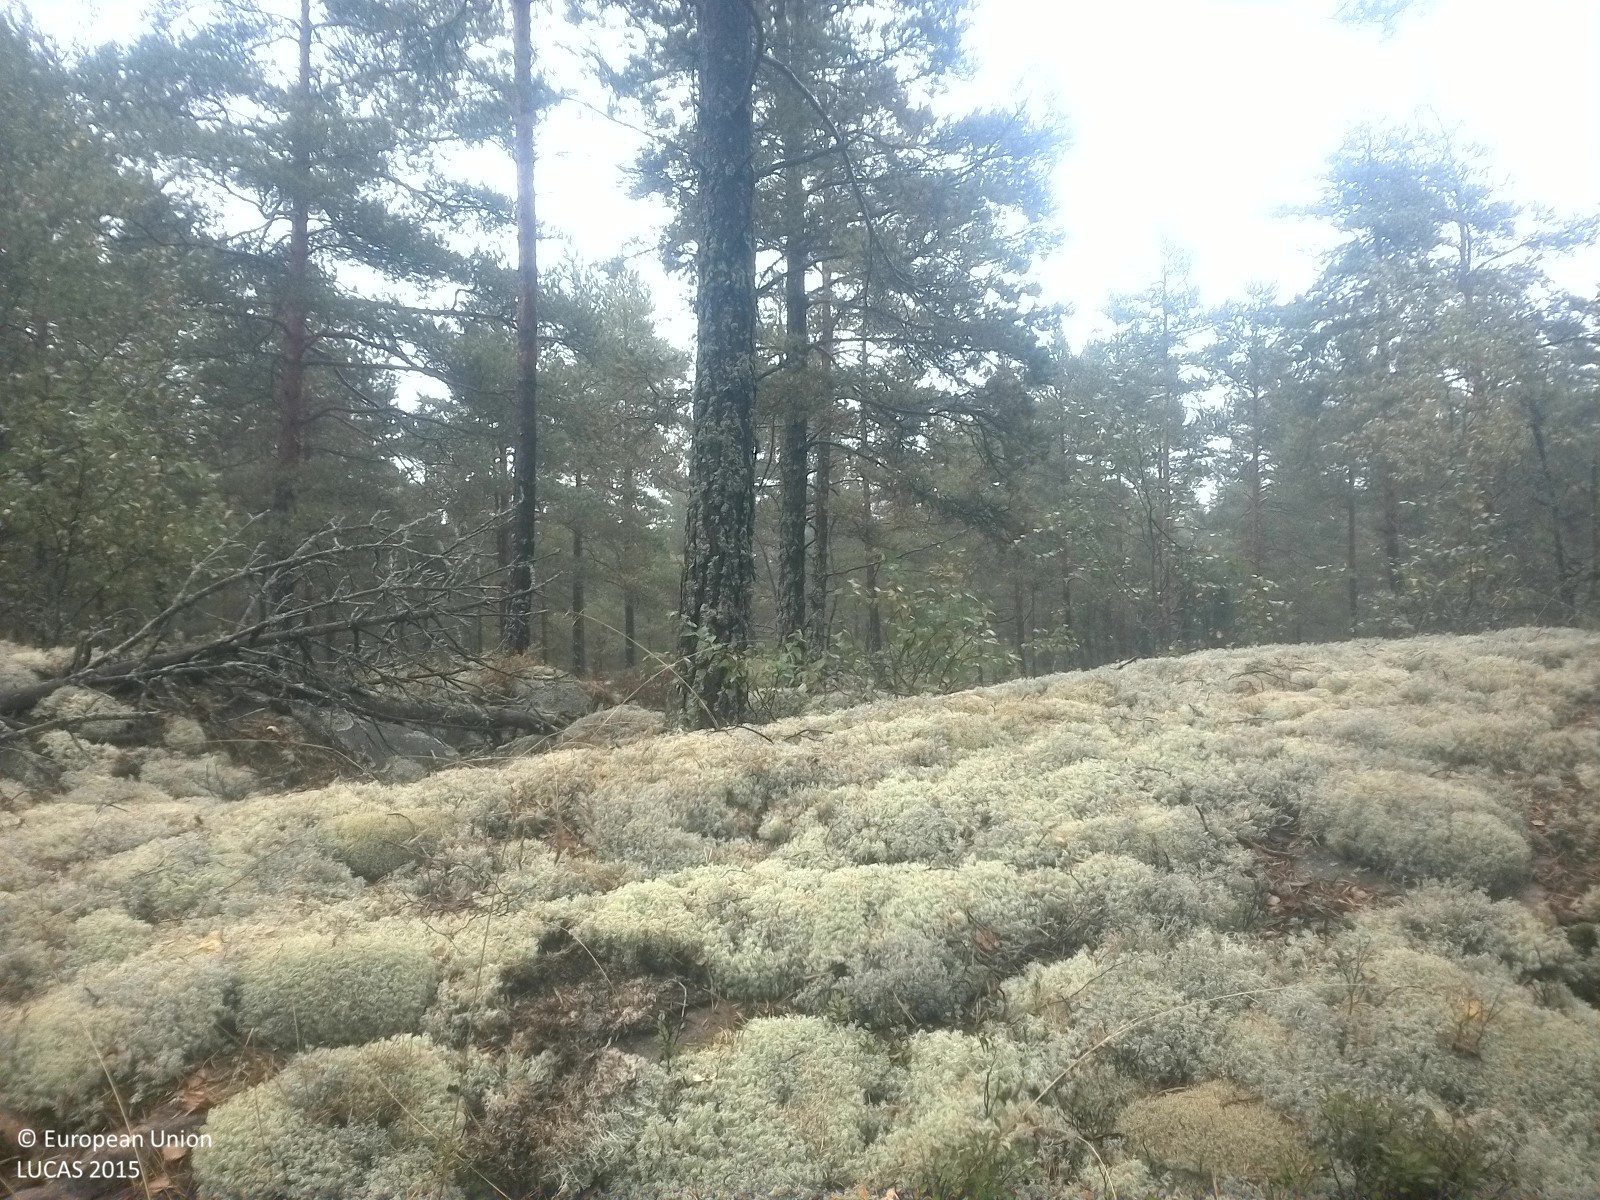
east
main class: Woodland
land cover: Pine dominated coniferous woodland
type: boreal forest
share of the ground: 10 - 25 %
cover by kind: herbaceous plants 35 %, lichens and mosses 25 %, coniferous forest trees 20 %, shrubs 20 %
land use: Forestry
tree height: > 5 m
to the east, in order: Pine dominated coniferous woodland; Broadleaved woodland; Pine dominated coniferous woodland
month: September
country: SE
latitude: 58.5572
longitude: 16.7167
